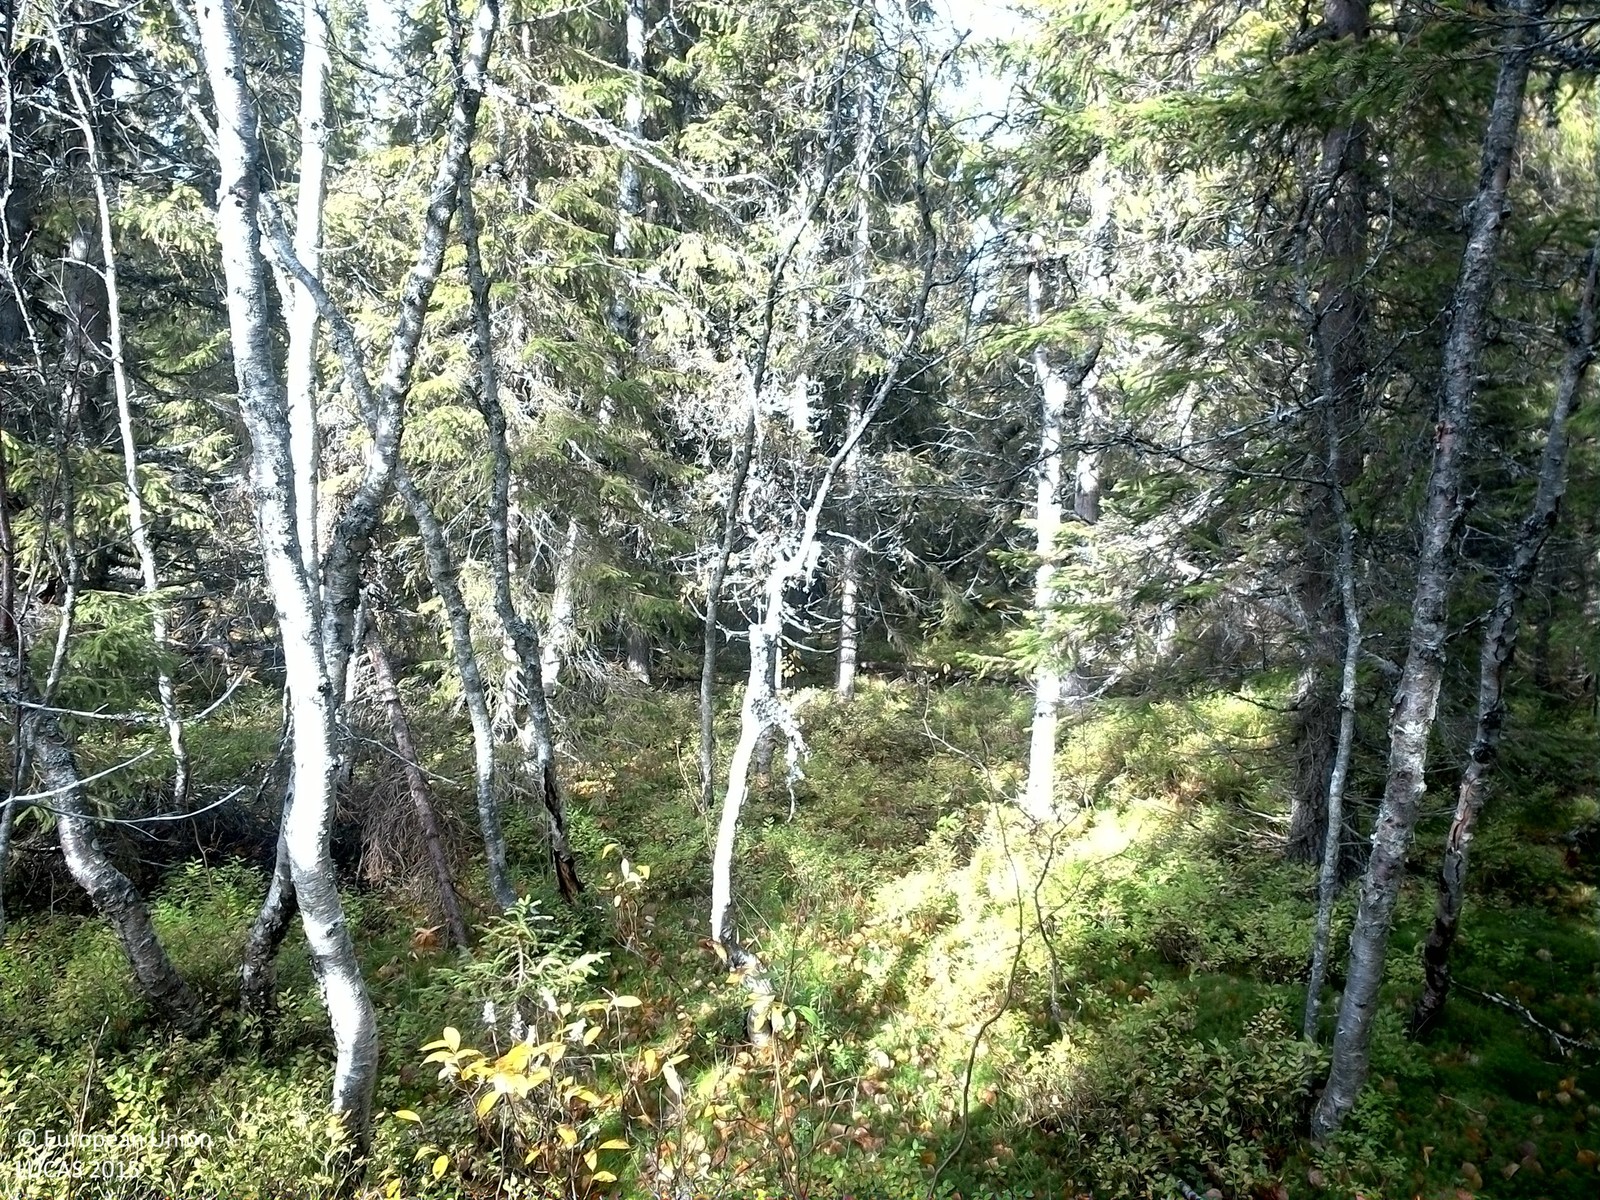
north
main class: Woodland
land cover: Spruce dominated coniferous woodland
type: boreal forest
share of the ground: 50 - 75 %
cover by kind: coniferous forest trees 50 %, shrubs 20 %, broadleaved forest trees 15 %, lichens and mosses 15 %
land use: Forestry
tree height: > 5 m
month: October
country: SE
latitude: 64.2120
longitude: 16.0068
